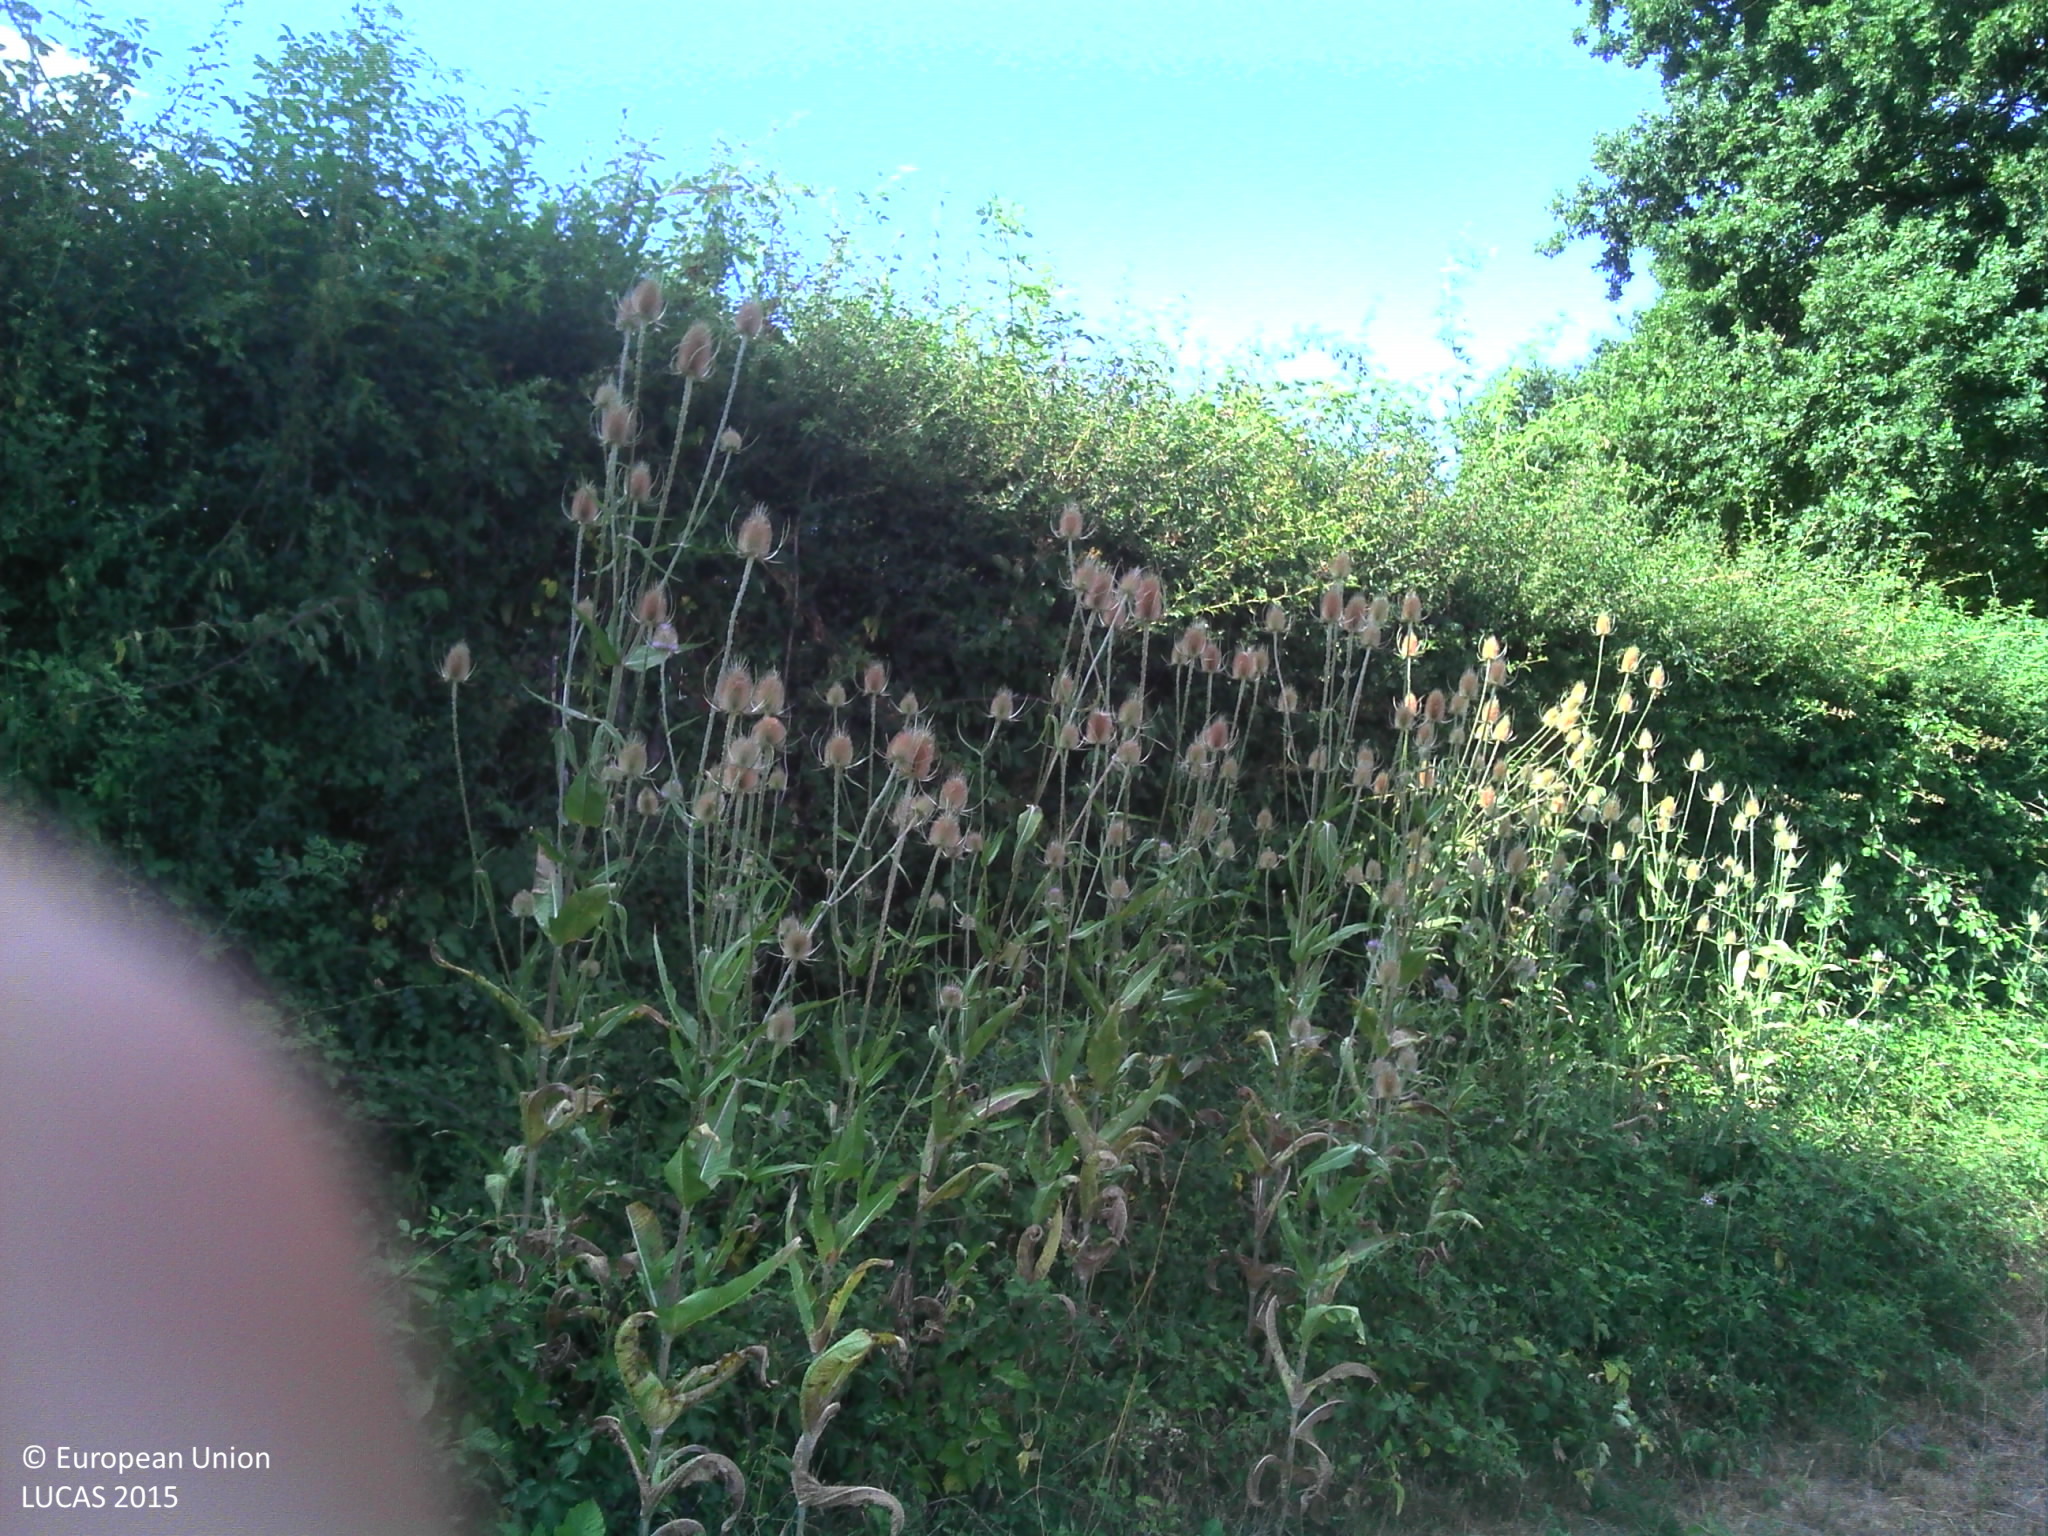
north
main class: Grassland
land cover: Grassland without tree/shrub cover
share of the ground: > 75 %
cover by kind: herbaceous plants 95 %, shrubs 5 %
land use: Agriculture (excluding fallow land and kitchen gardens)
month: July
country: FR
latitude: 46.4817
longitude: 2.9761
